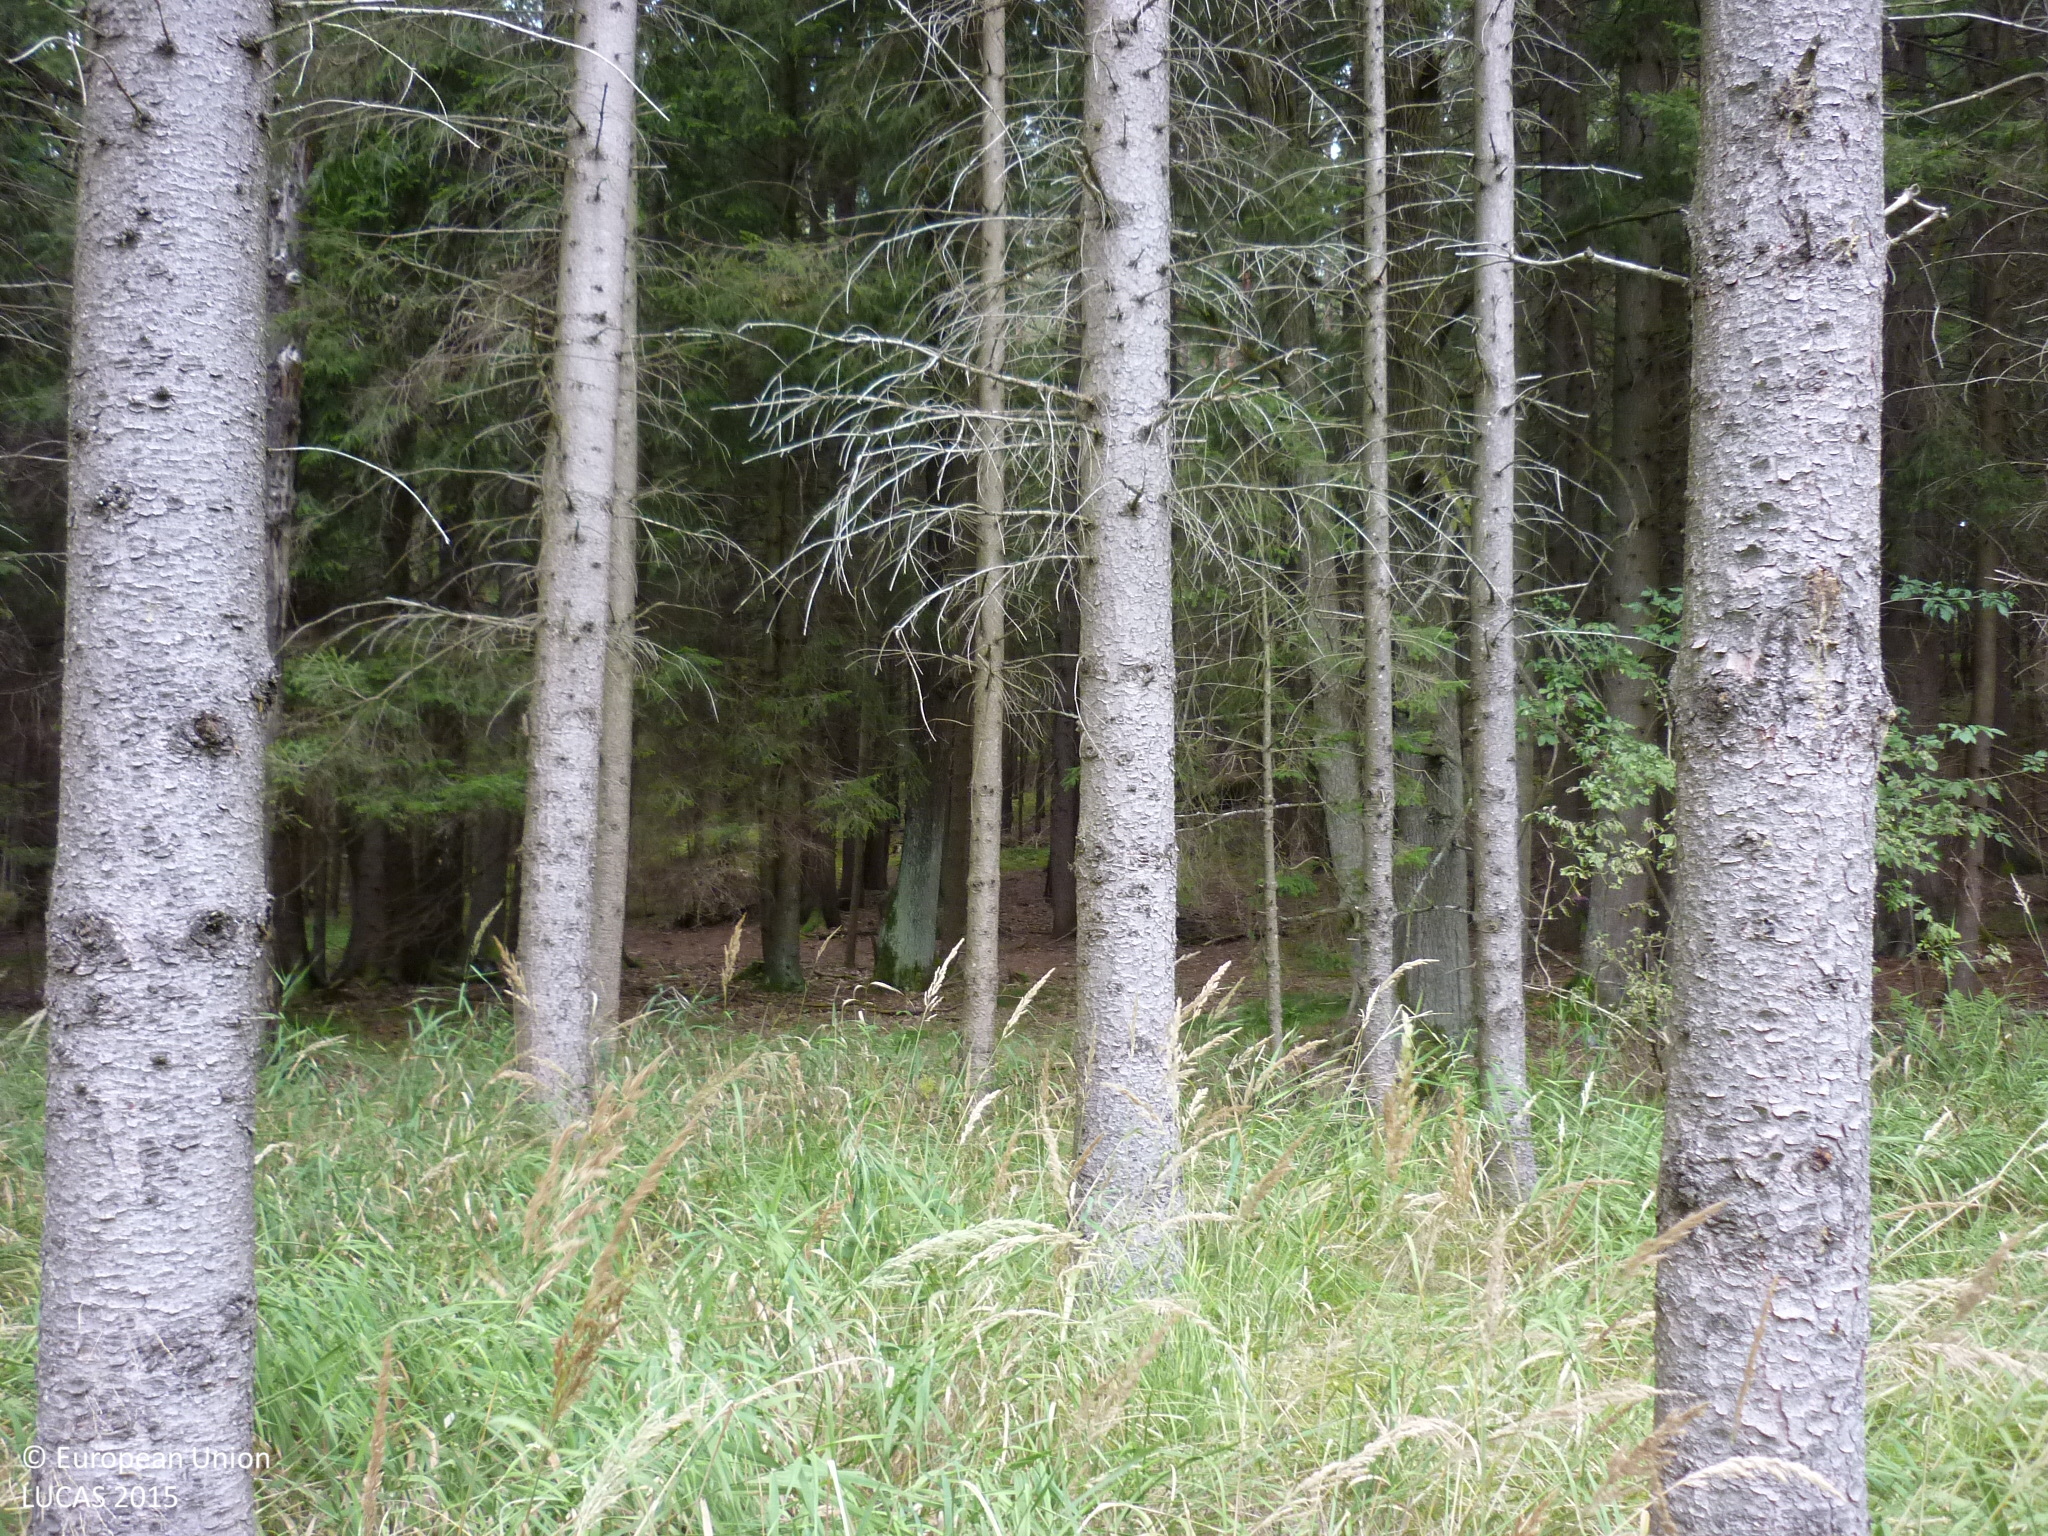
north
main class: Woodland
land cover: Spruce dominated coniferous woodland
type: hemiboreal forest and nemoral coniferous forest and mixed broadleaved-coniferous forest
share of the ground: 50 - 75 %
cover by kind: coniferous forest trees 65 %, herbaceous plants 20 %, shrubs 10 %, broadleaved forest trees 5 %
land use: Forestry
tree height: > 5 m
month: September
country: AT
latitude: 48.7736
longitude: 15.0775
